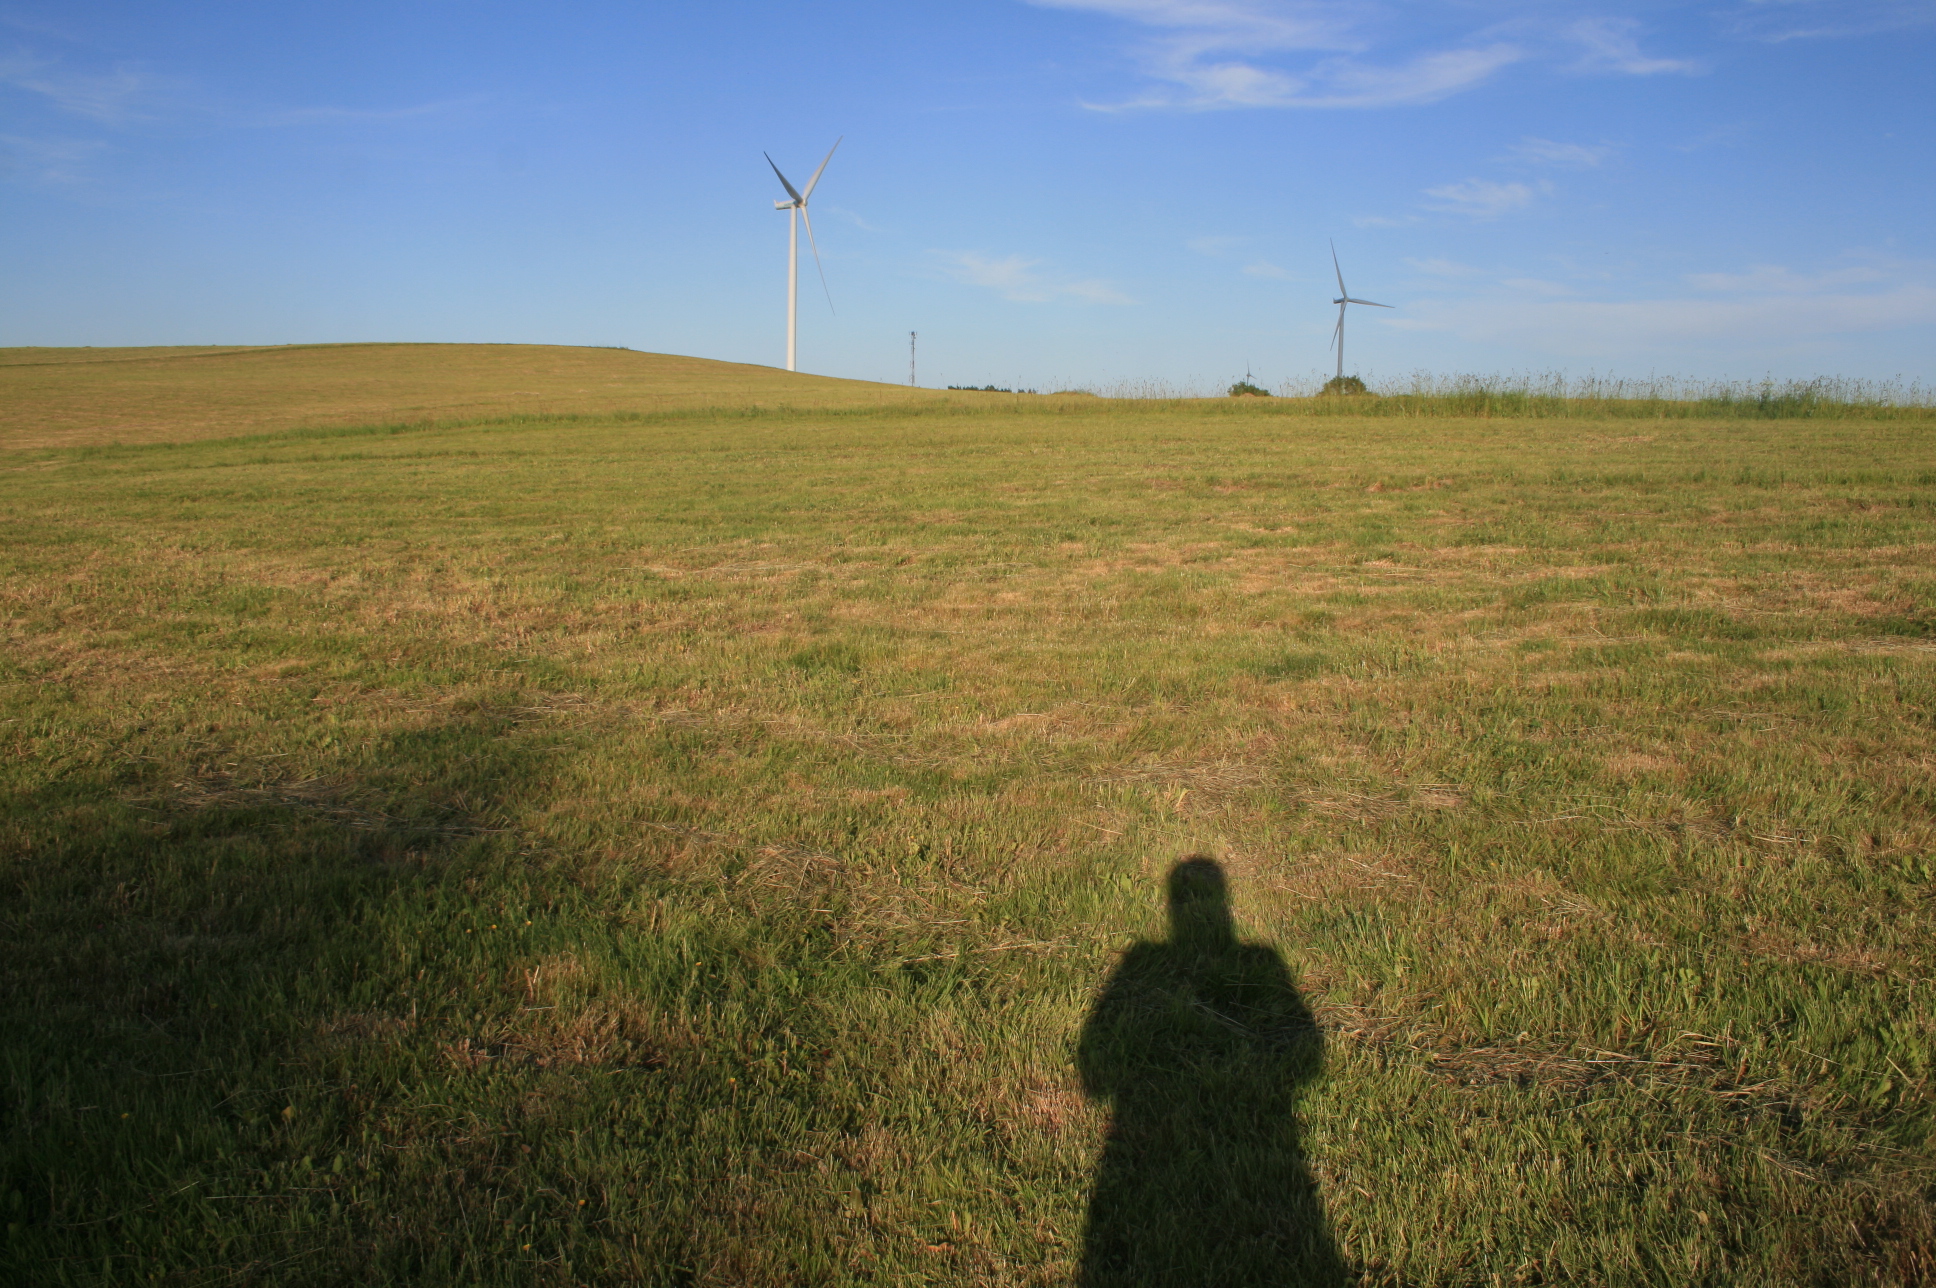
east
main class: Grassland
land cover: Grassland without tree/shrub cover
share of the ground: > 75 %
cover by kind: herbaceous plants 100 %
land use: Agriculture (excluding fallow land and kitchen gardens)
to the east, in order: Grassland without tree/shrub cover
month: June
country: LT
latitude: 55.5678
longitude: 22.1871
